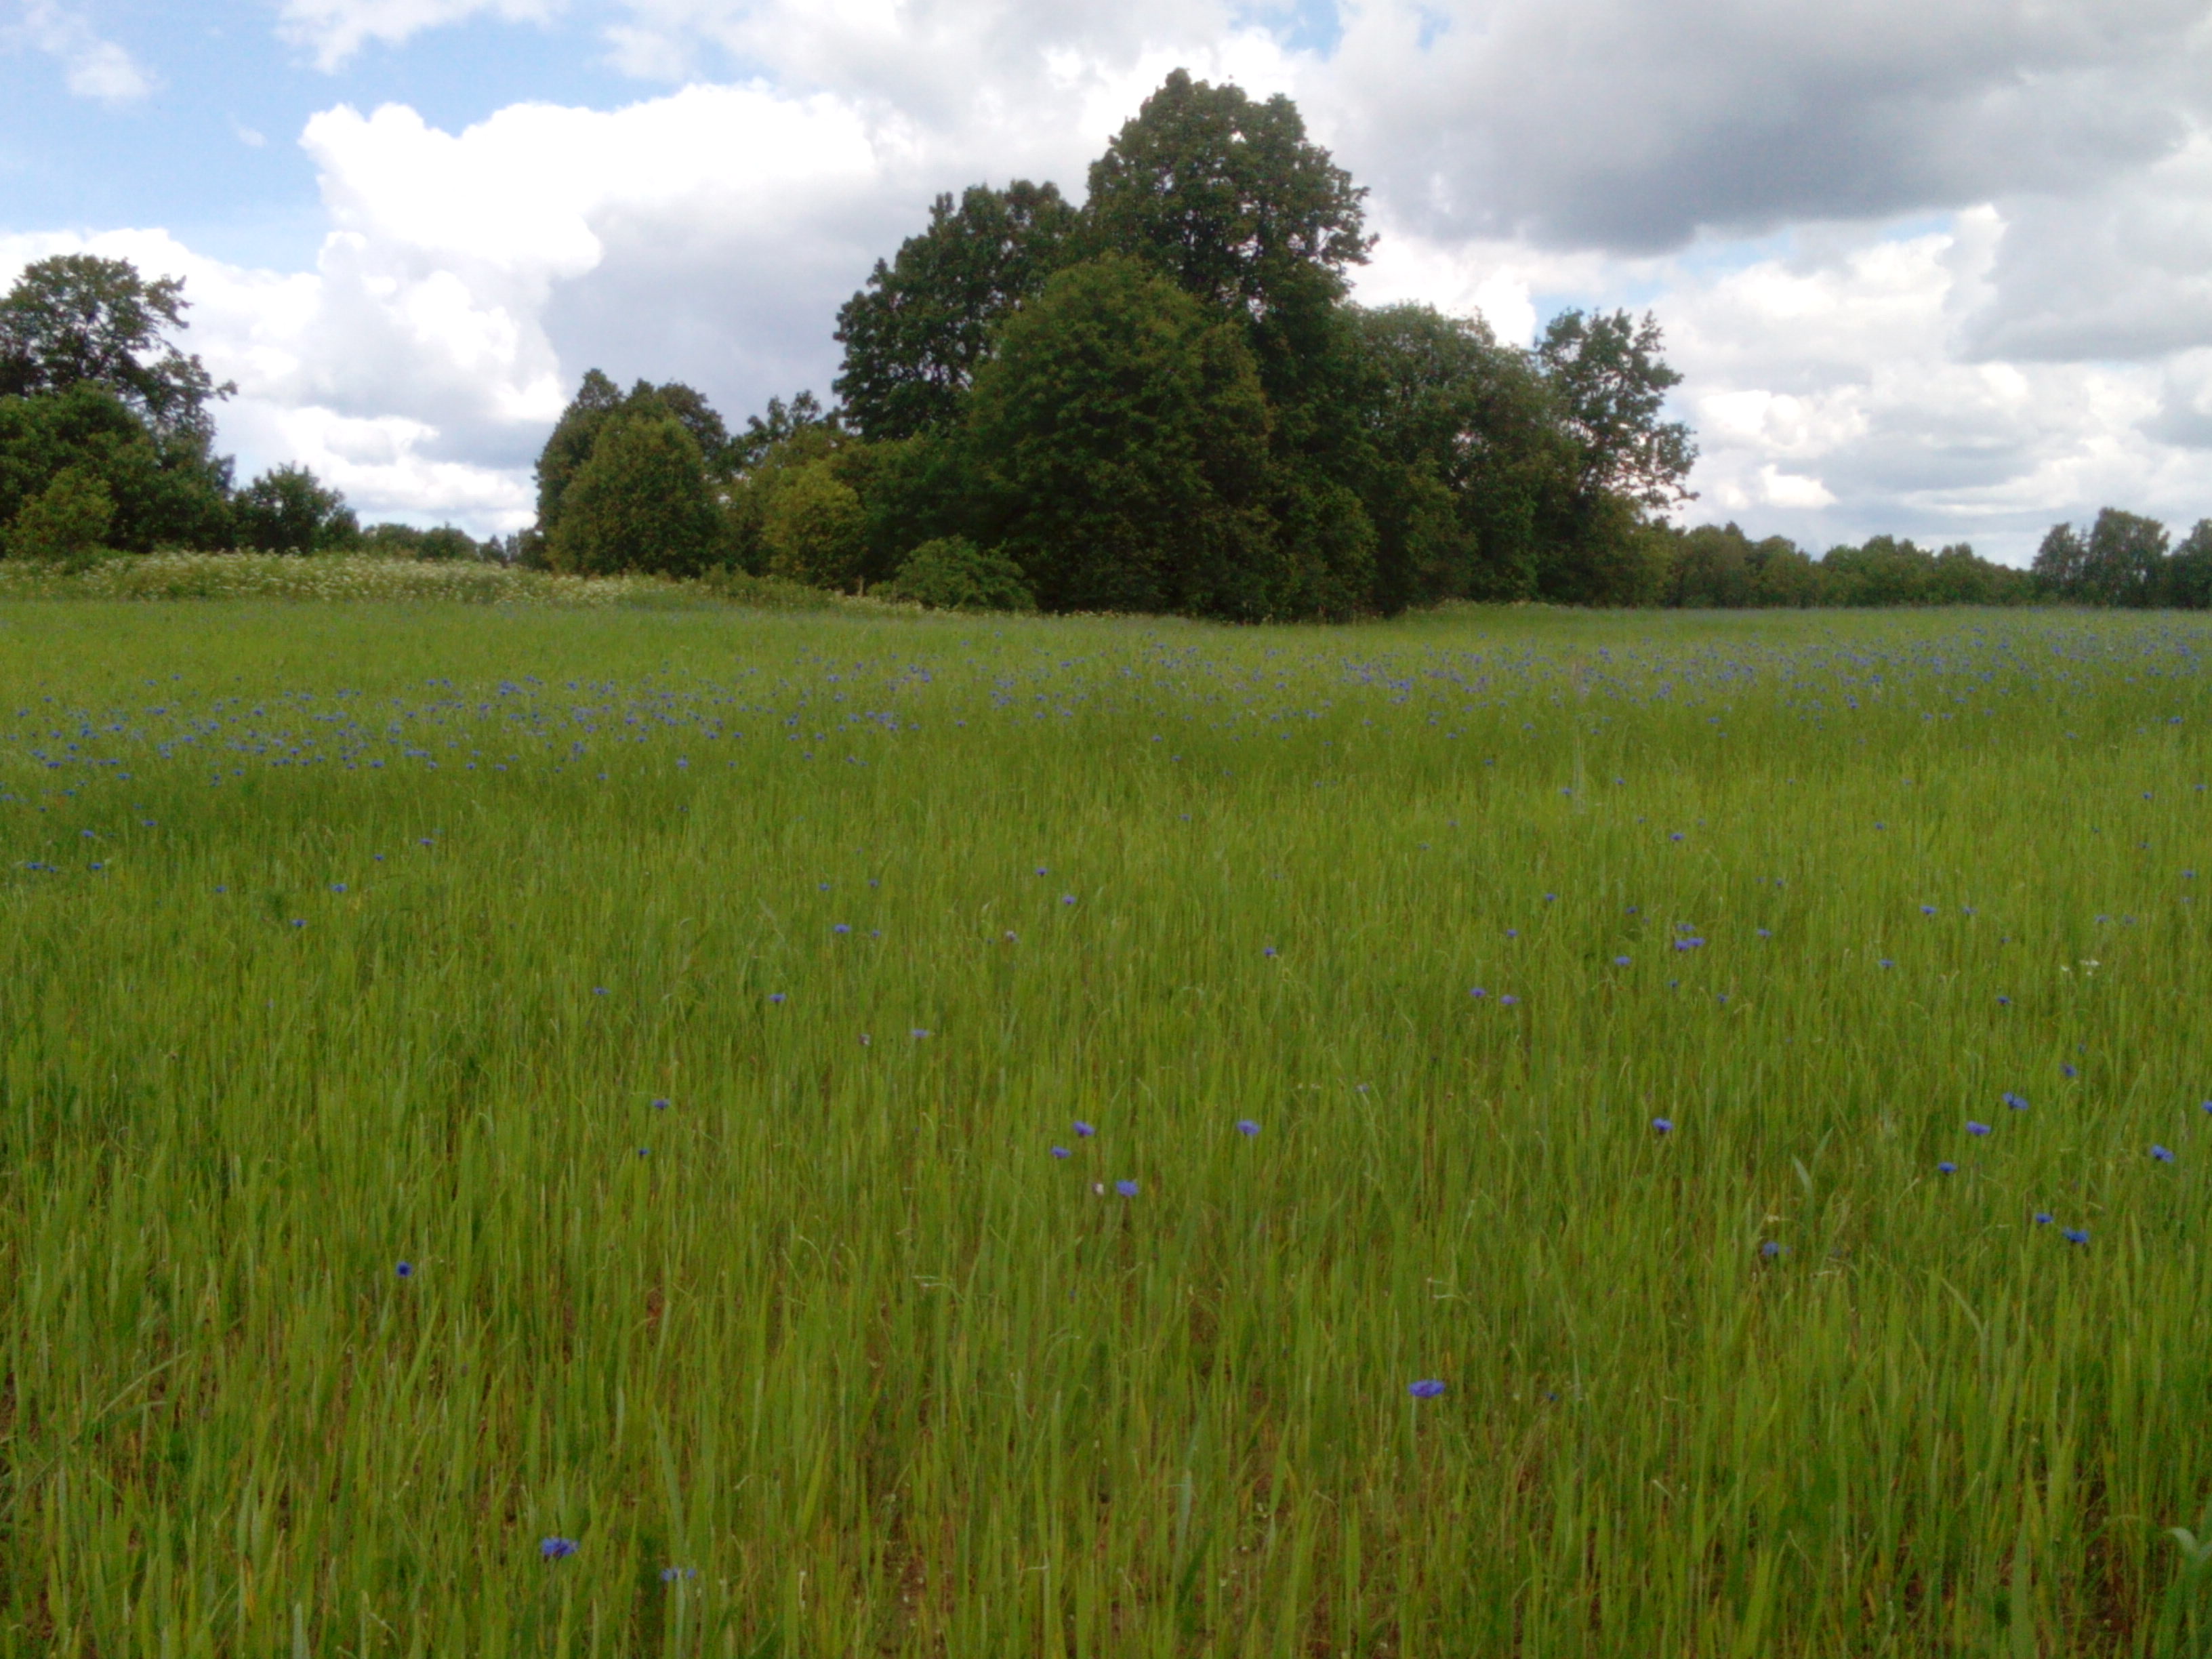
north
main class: Cropland
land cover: Common wheat
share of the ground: > 75 %
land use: Agriculture (excluding fallow land and kitchen gardens)
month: June
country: LV
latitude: 56.7801
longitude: 21.8793
